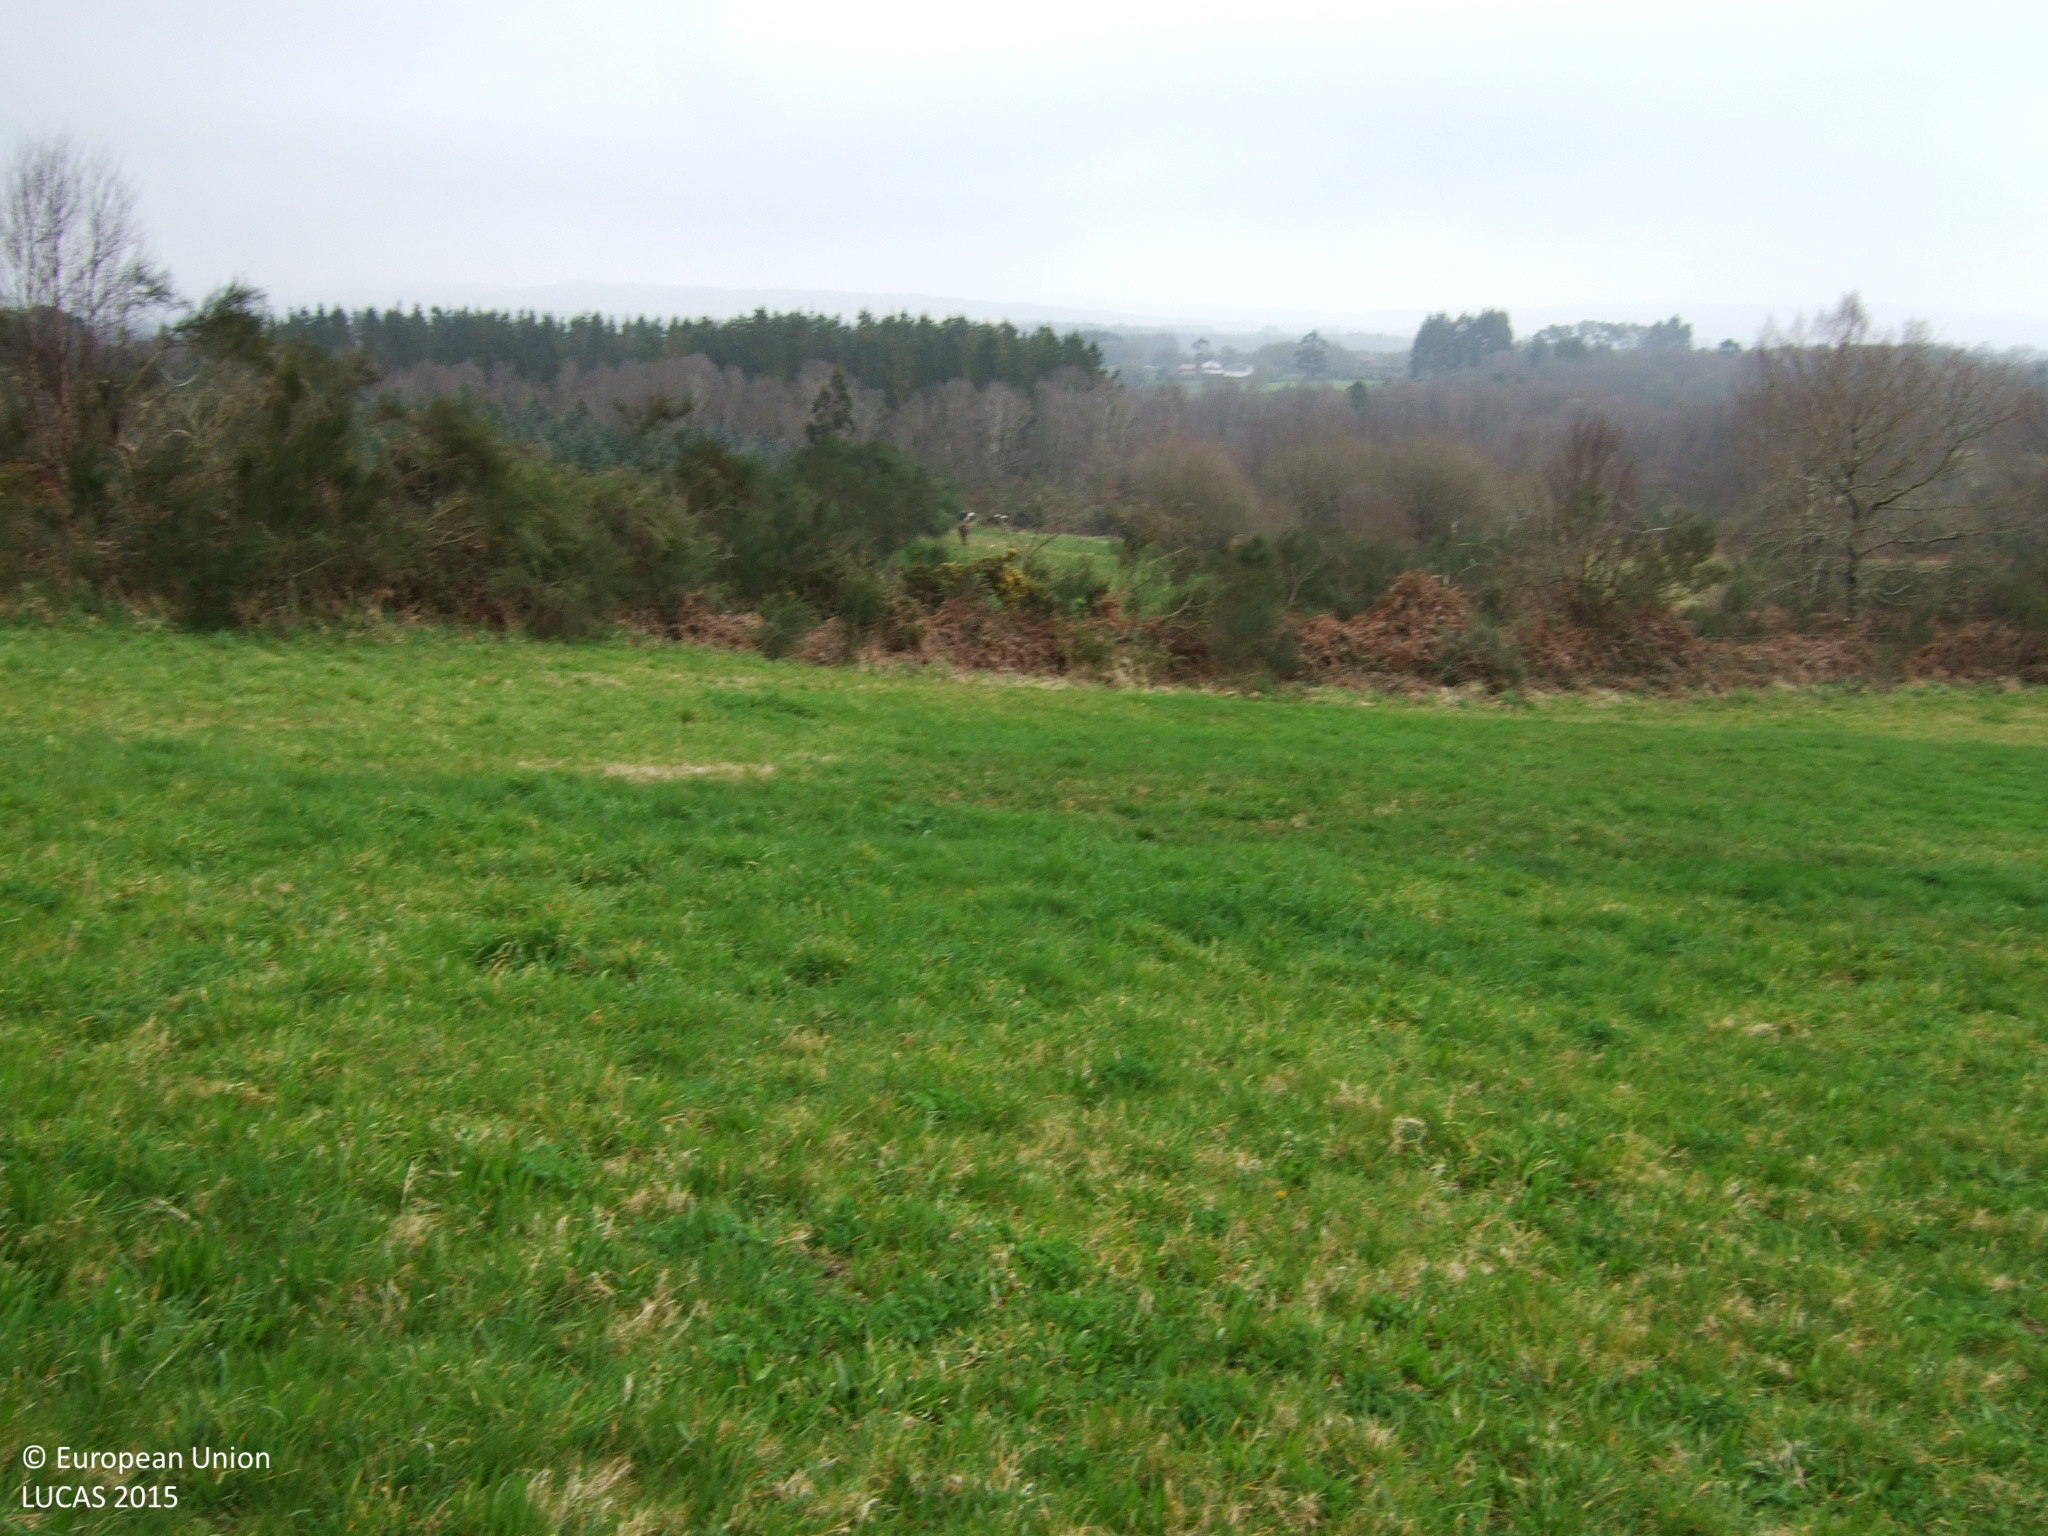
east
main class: Grassland
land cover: Grassland without tree/shrub cover
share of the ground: > 75 %
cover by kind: herbaceous plants 100 %
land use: Agriculture (excluding fallow land and kitchen gardens)
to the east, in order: Grassland without tree/shrub cover; Electric lines; Shrubland without tree cover; Grassland without tree/shrub cover; Fences; Shrubland without tree cover; Tracks; Broadleaved woodland
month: March
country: ES
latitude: 42.9540
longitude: -7.8460
